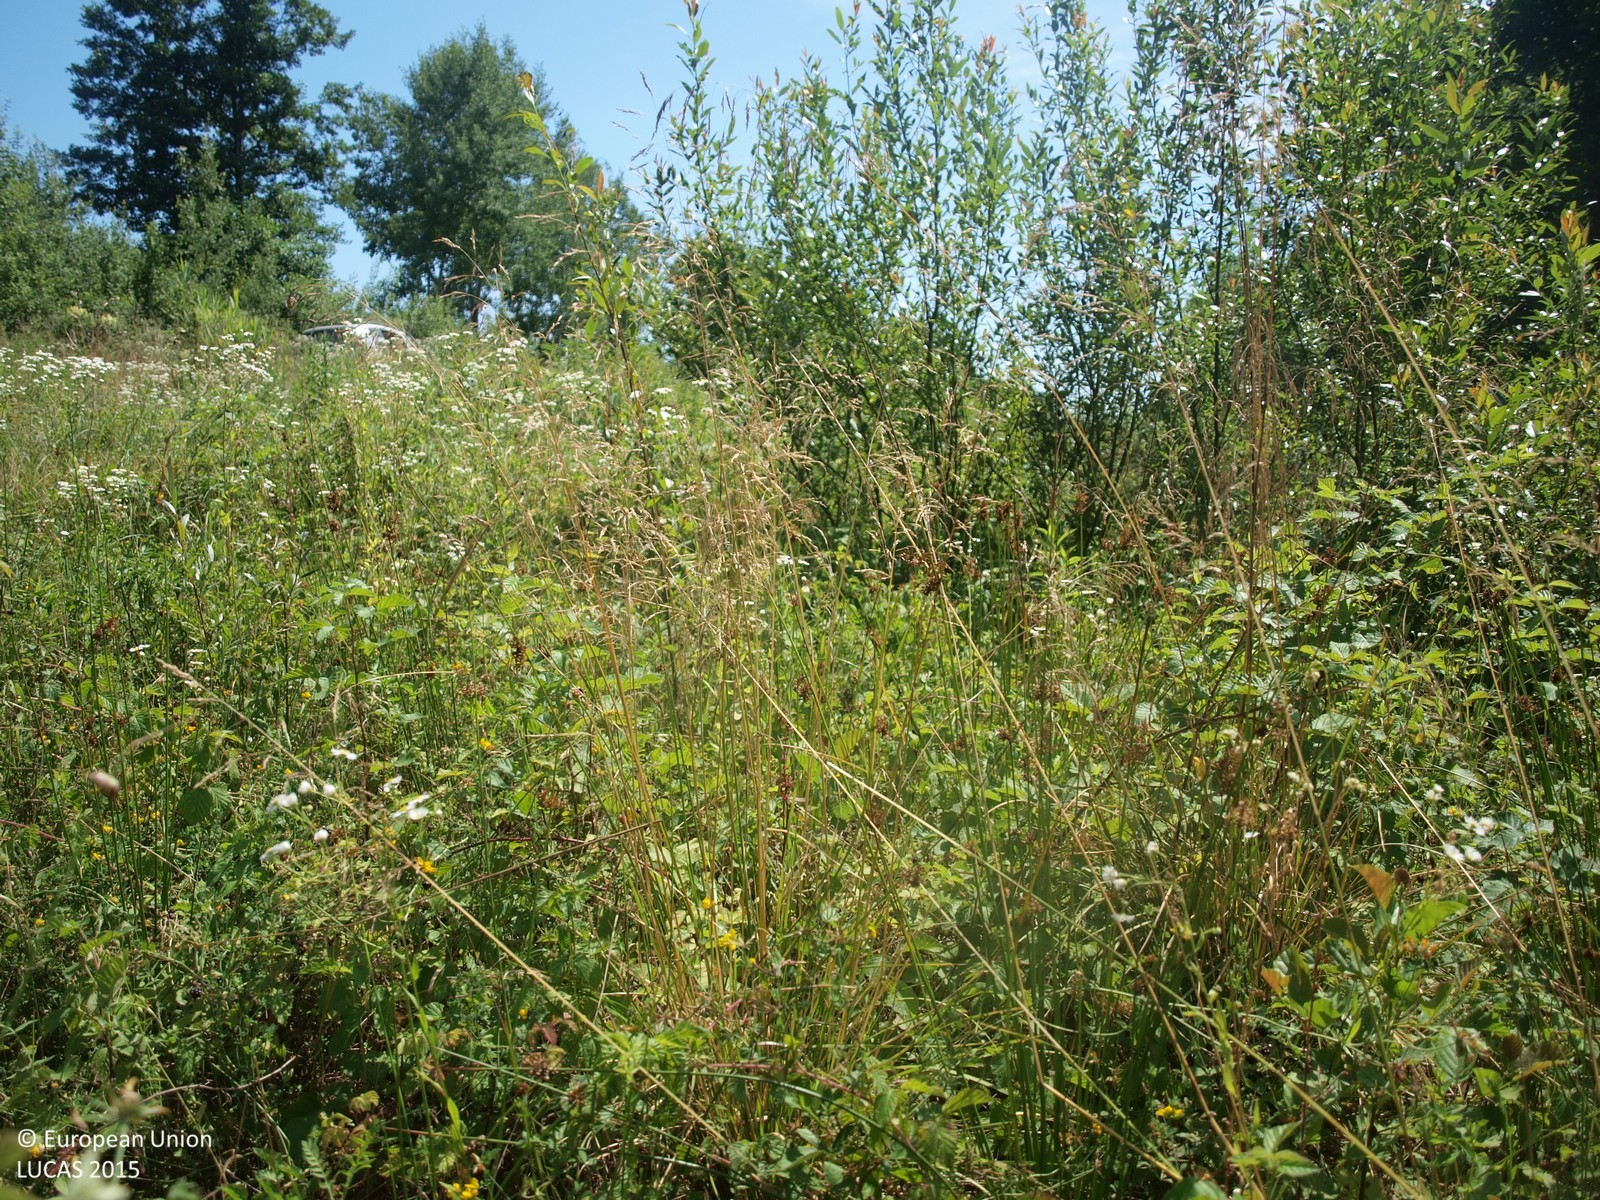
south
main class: Woodland
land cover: Broadleaved woodland
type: floodplain forest
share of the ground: > 75 %
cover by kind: broadleaved forest trees 100 %
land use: Forestry
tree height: > 5 m
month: July
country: HR
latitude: 45.6377
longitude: 15.7315
